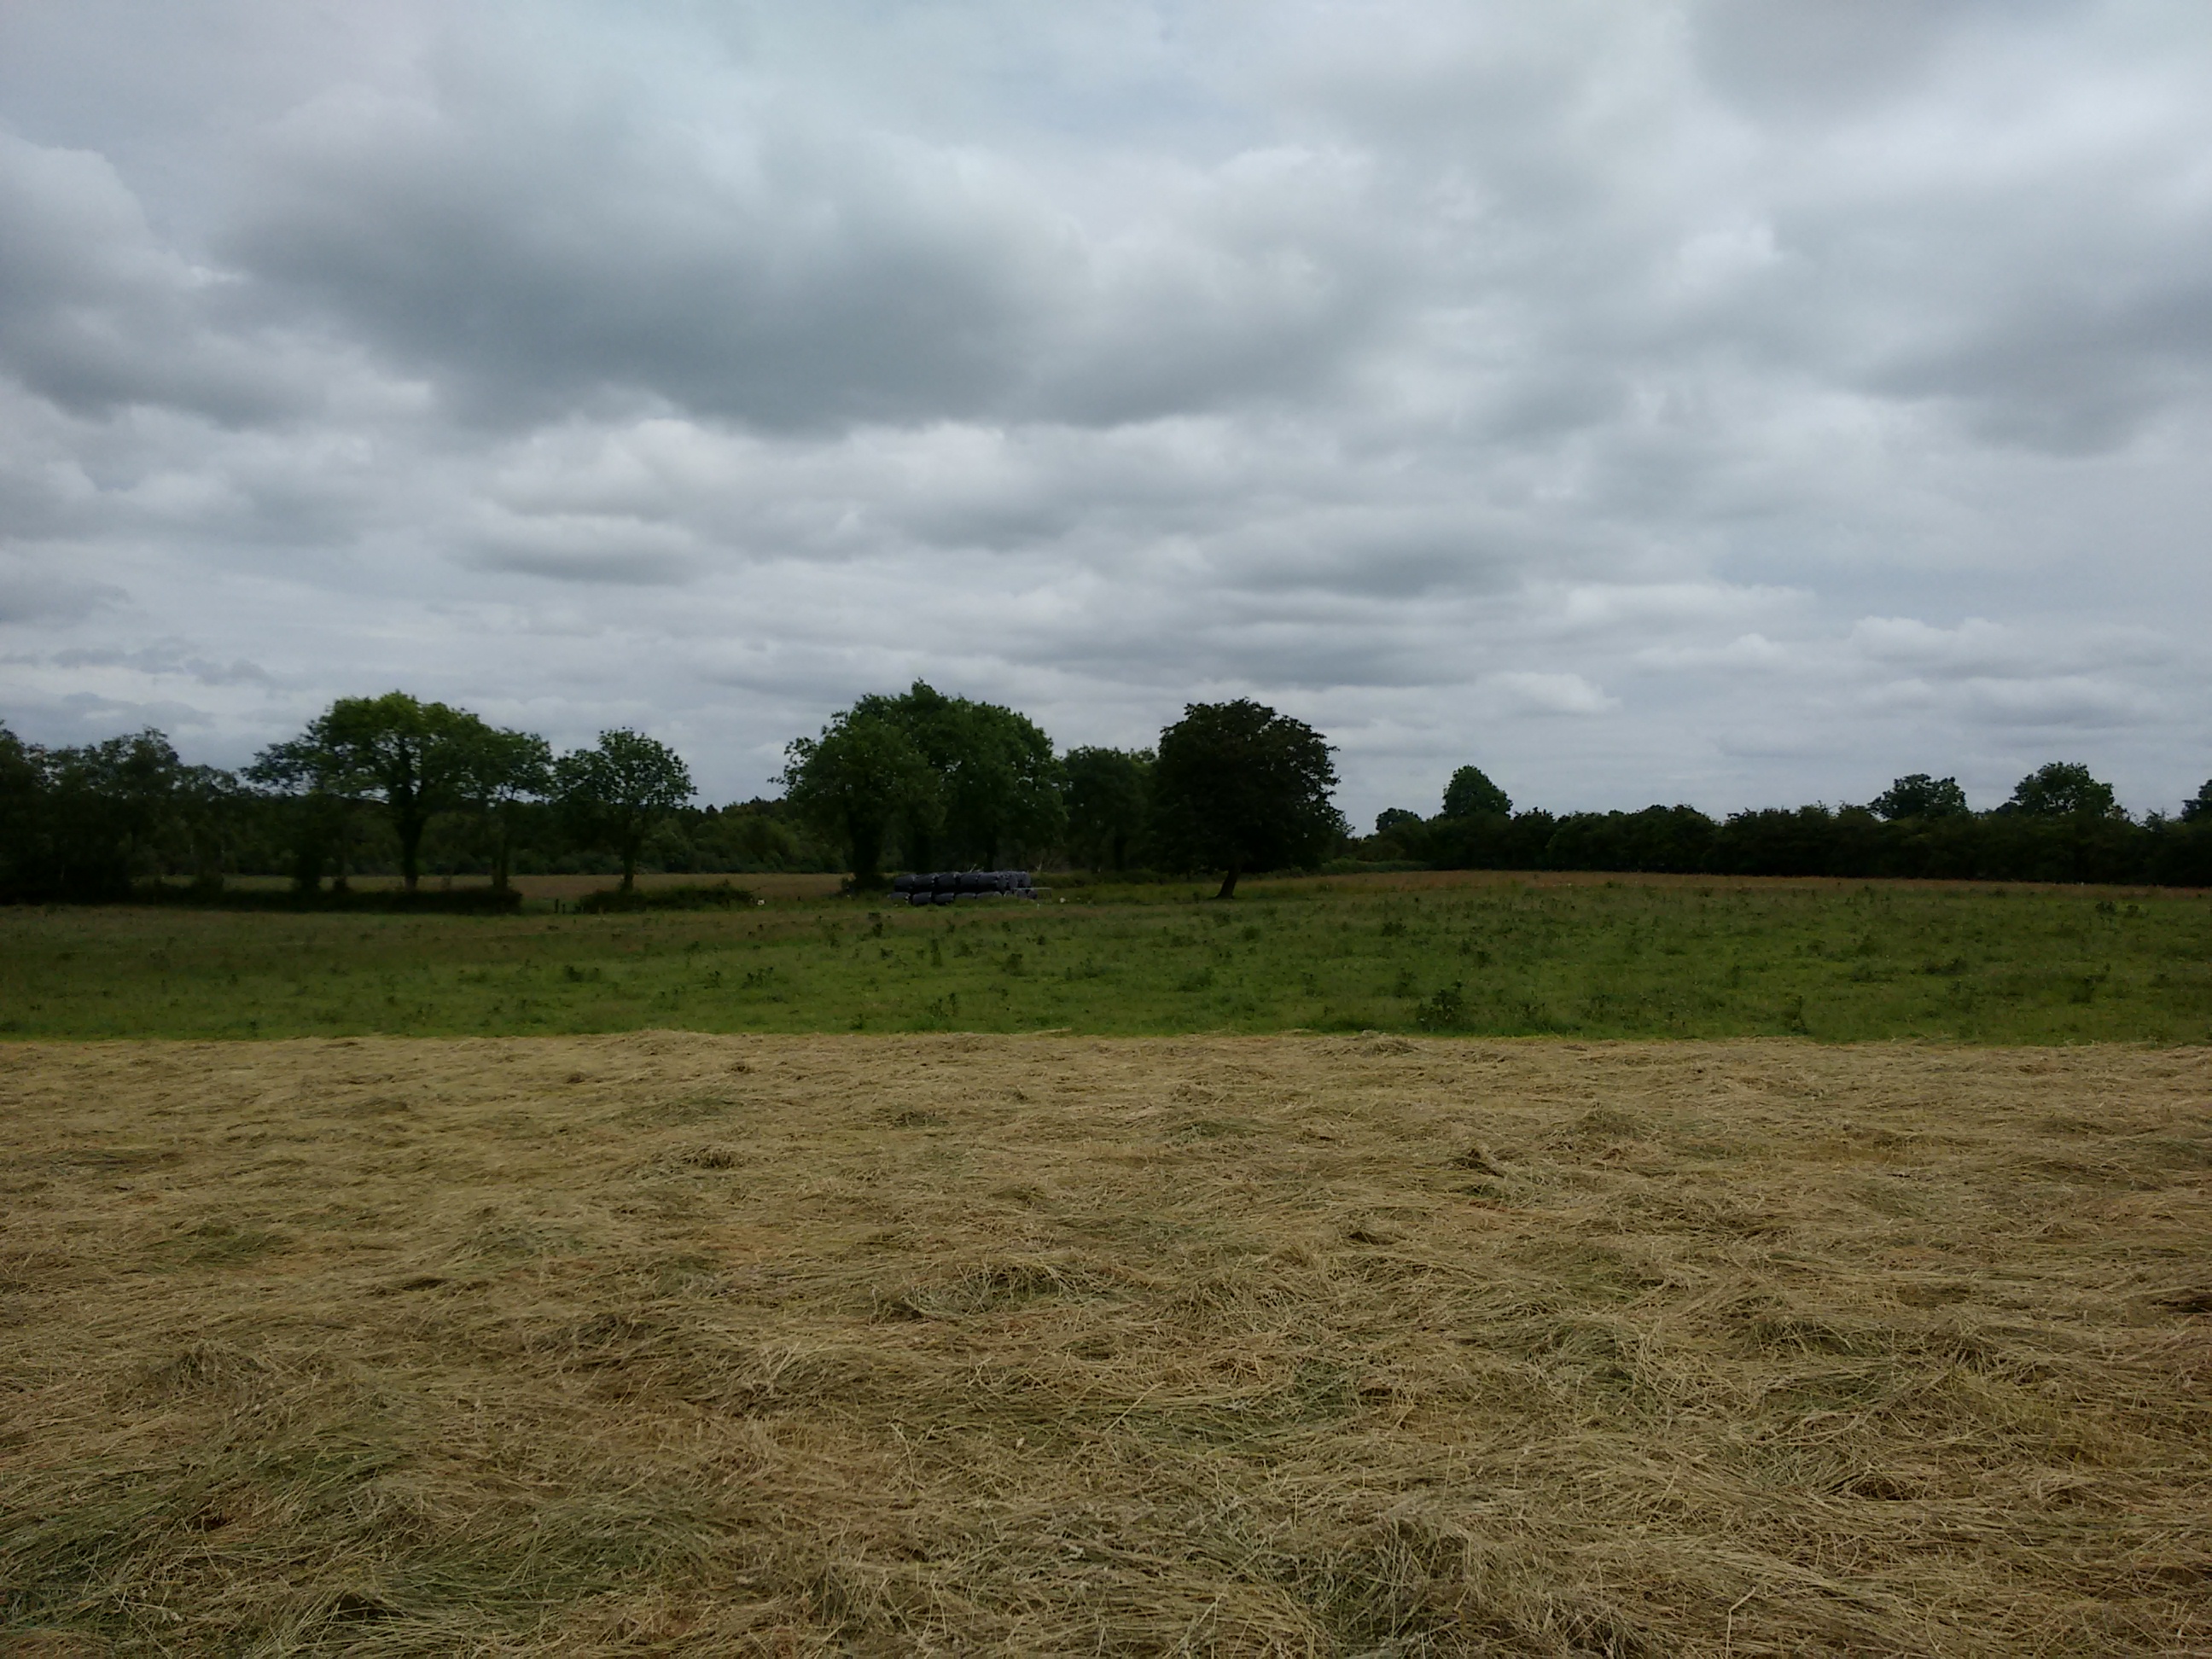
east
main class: Grassland
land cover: Grassland without tree/shrub cover
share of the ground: > 75 %
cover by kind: herbaceous plants 95 %, consolidated bare surface 5 %
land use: Agriculture (excluding fallow land and kitchen gardens)
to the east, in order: Grassland without tree/shrub cover; Fences; Broadleaved woodland; Ditches and canals; Grassland with sparse tree/shrub cover
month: June
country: IE
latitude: 53.4201
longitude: -7.6323
